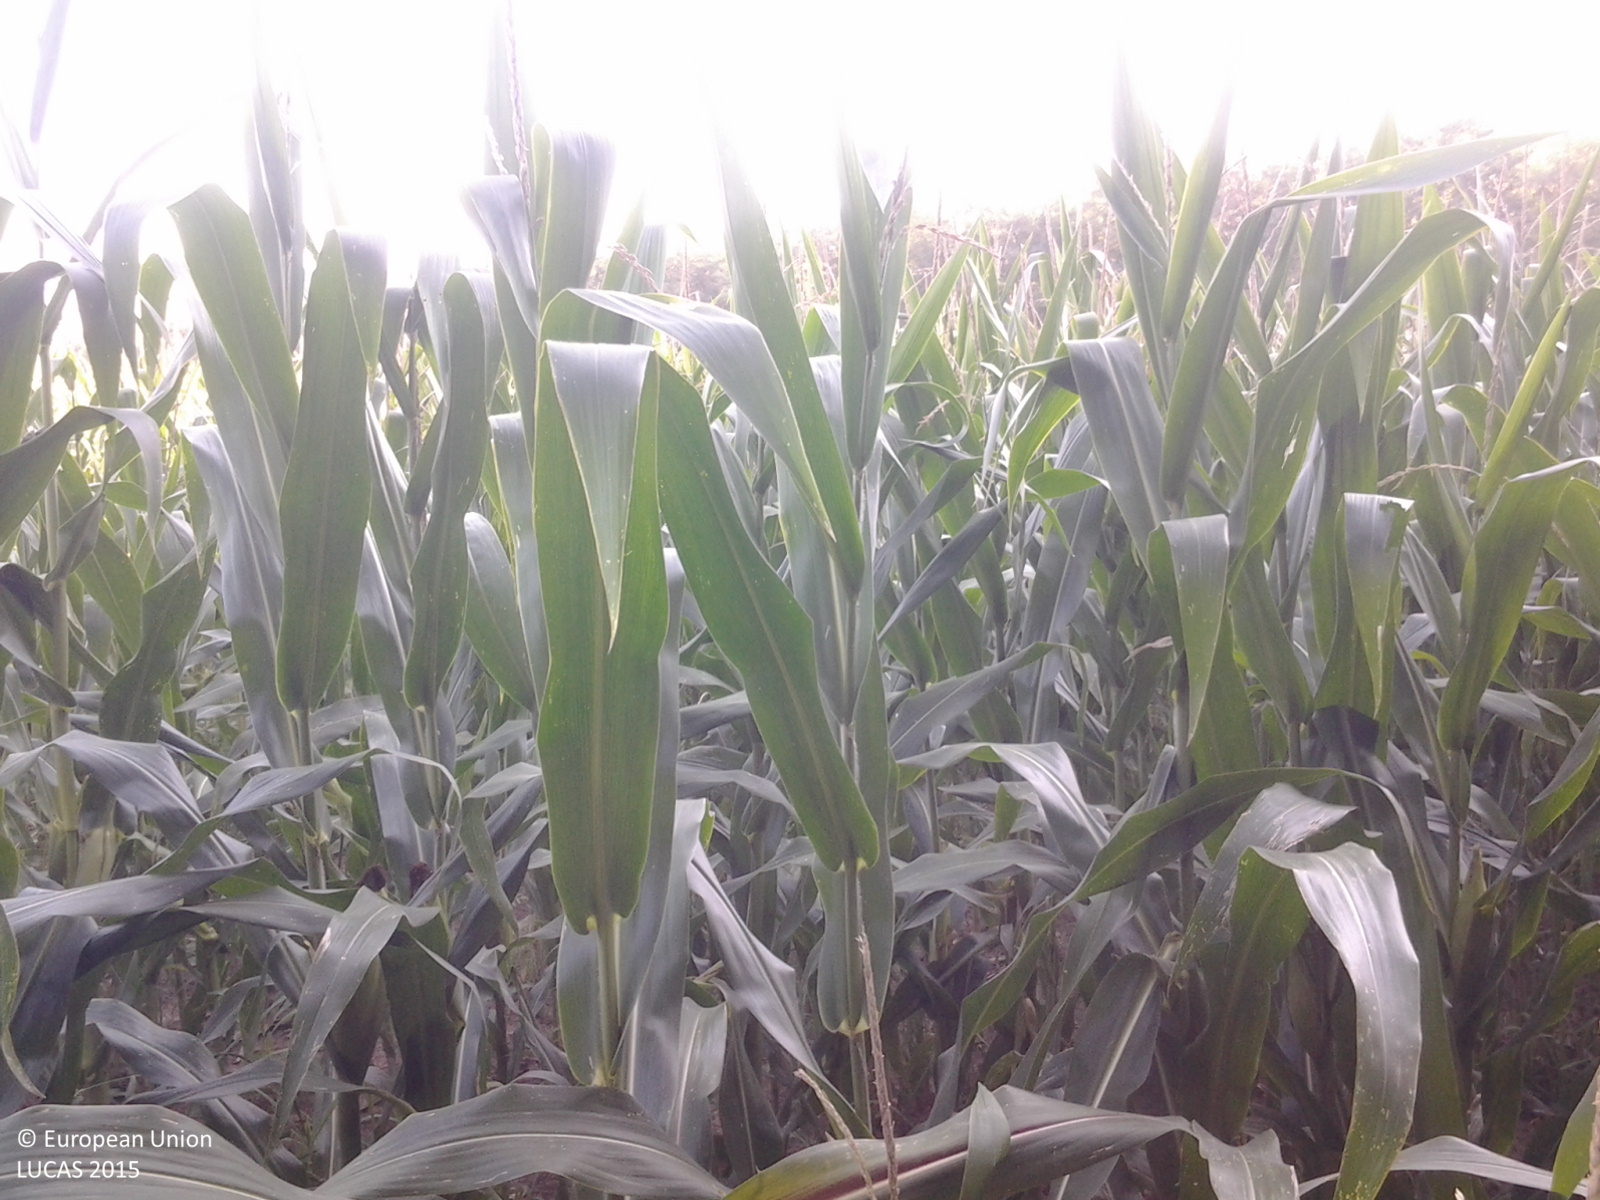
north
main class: Cropland
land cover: Maize
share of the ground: > 75 %
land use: Agriculture (excluding fallow land and kitchen gardens)
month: August
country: HU
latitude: 46.8954
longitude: 21.4719
